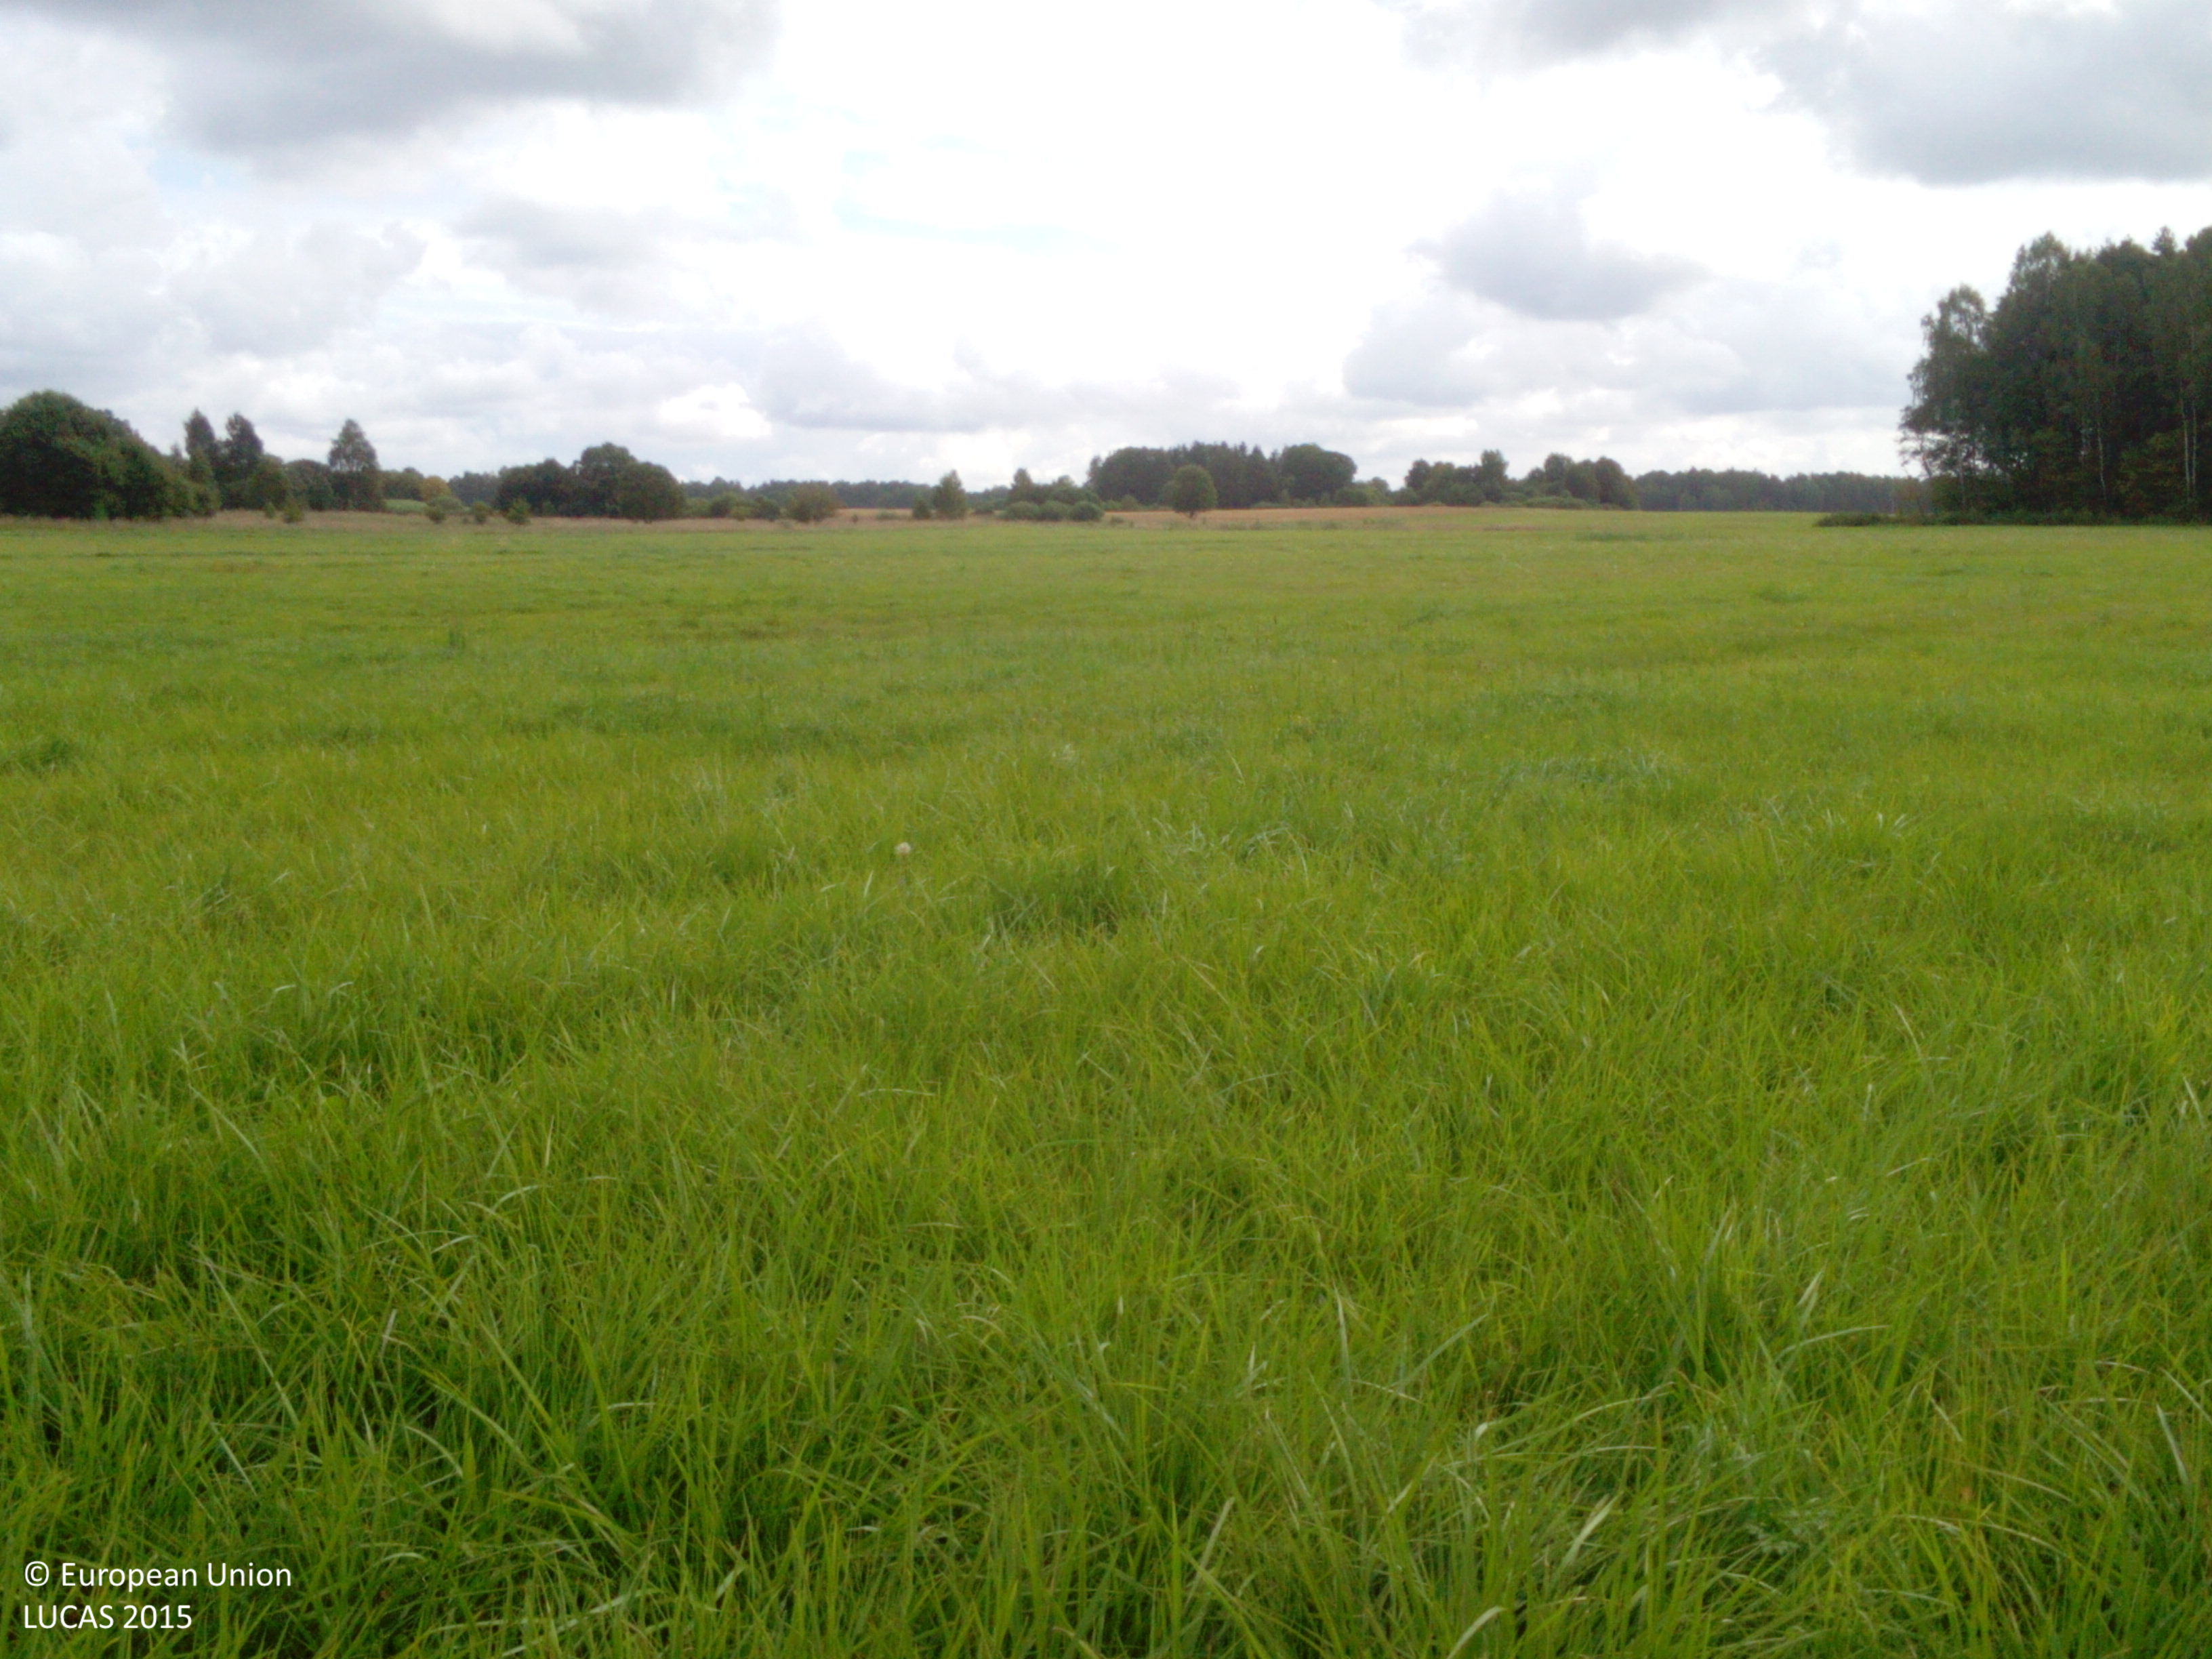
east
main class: Grassland
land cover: Grassland without tree/shrub cover
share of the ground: > 75 %
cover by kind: herbaceous plants 100 %
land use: Agriculture (excluding fallow land and kitchen gardens)
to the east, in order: Grassland without tree/shrub cover
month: August
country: LV
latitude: 56.3043
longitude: 21.3054
